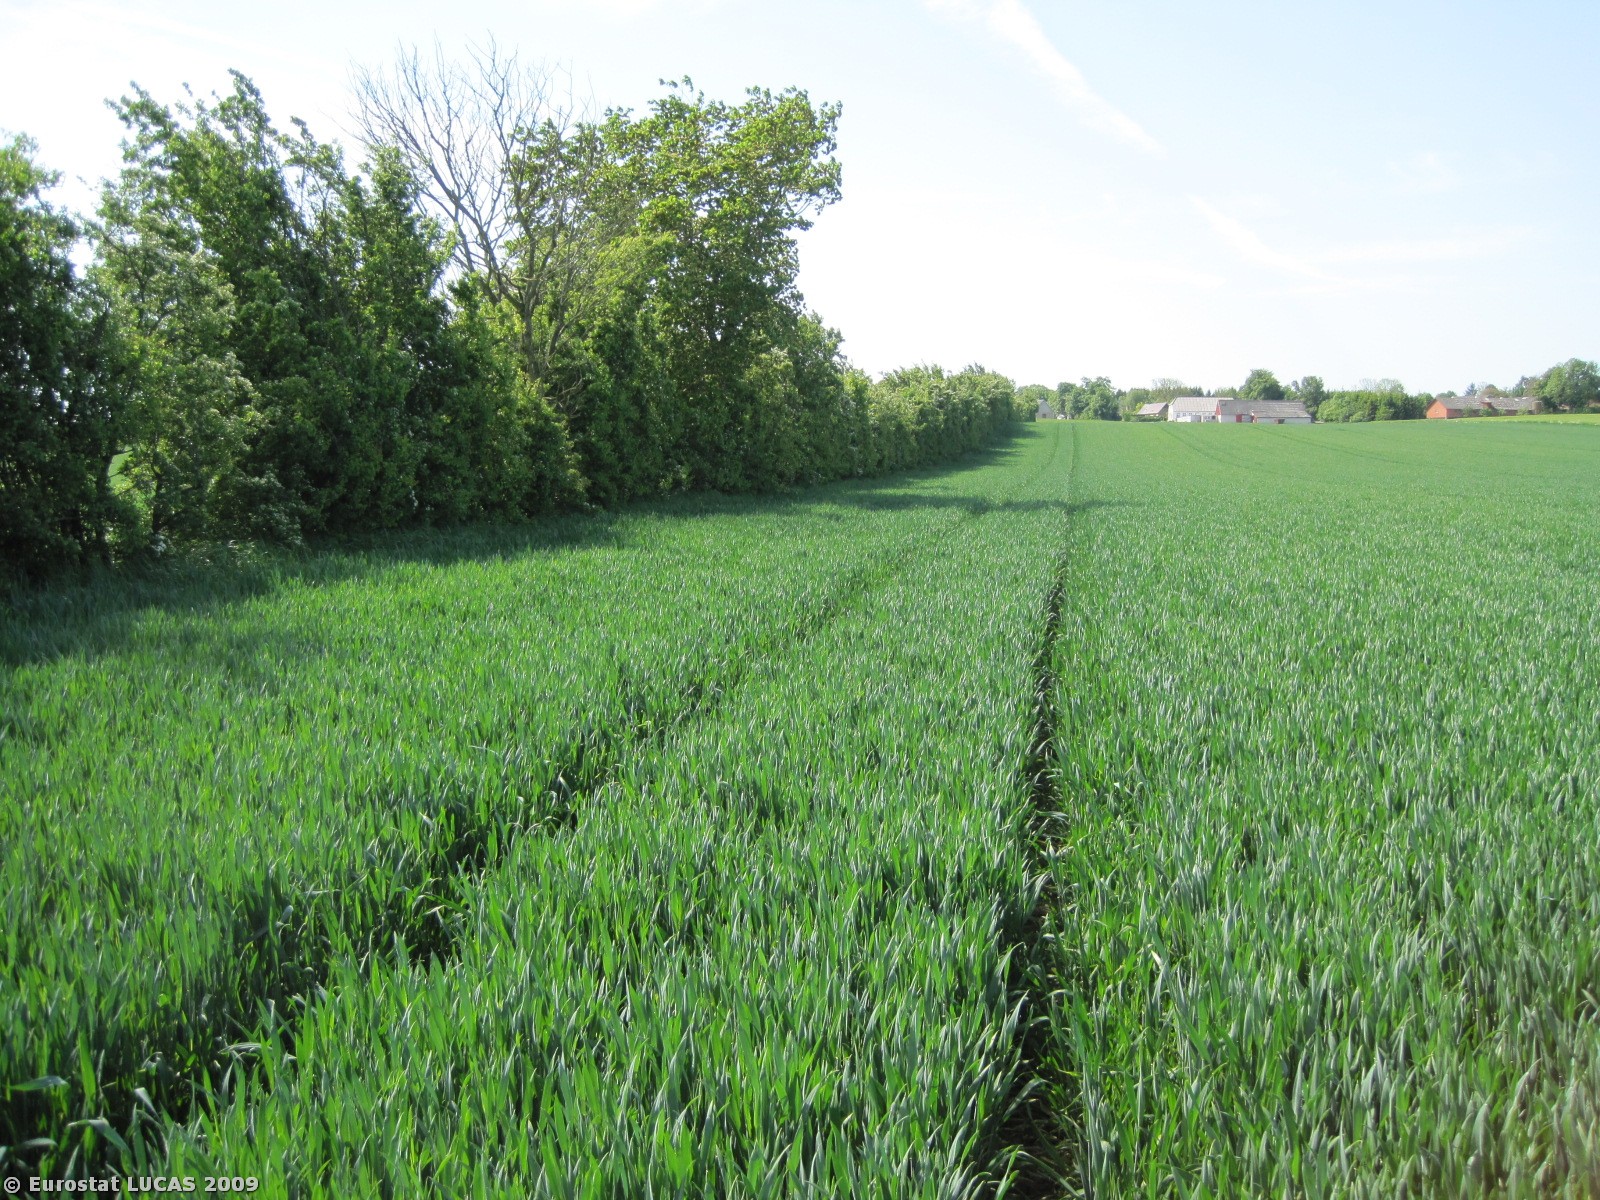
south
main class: Cropland
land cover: Common wheat
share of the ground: > 75 %
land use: Agriculture (excluding fallow land and kitchen gardens)
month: May
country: DK
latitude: 56.5112
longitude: 10.1785
